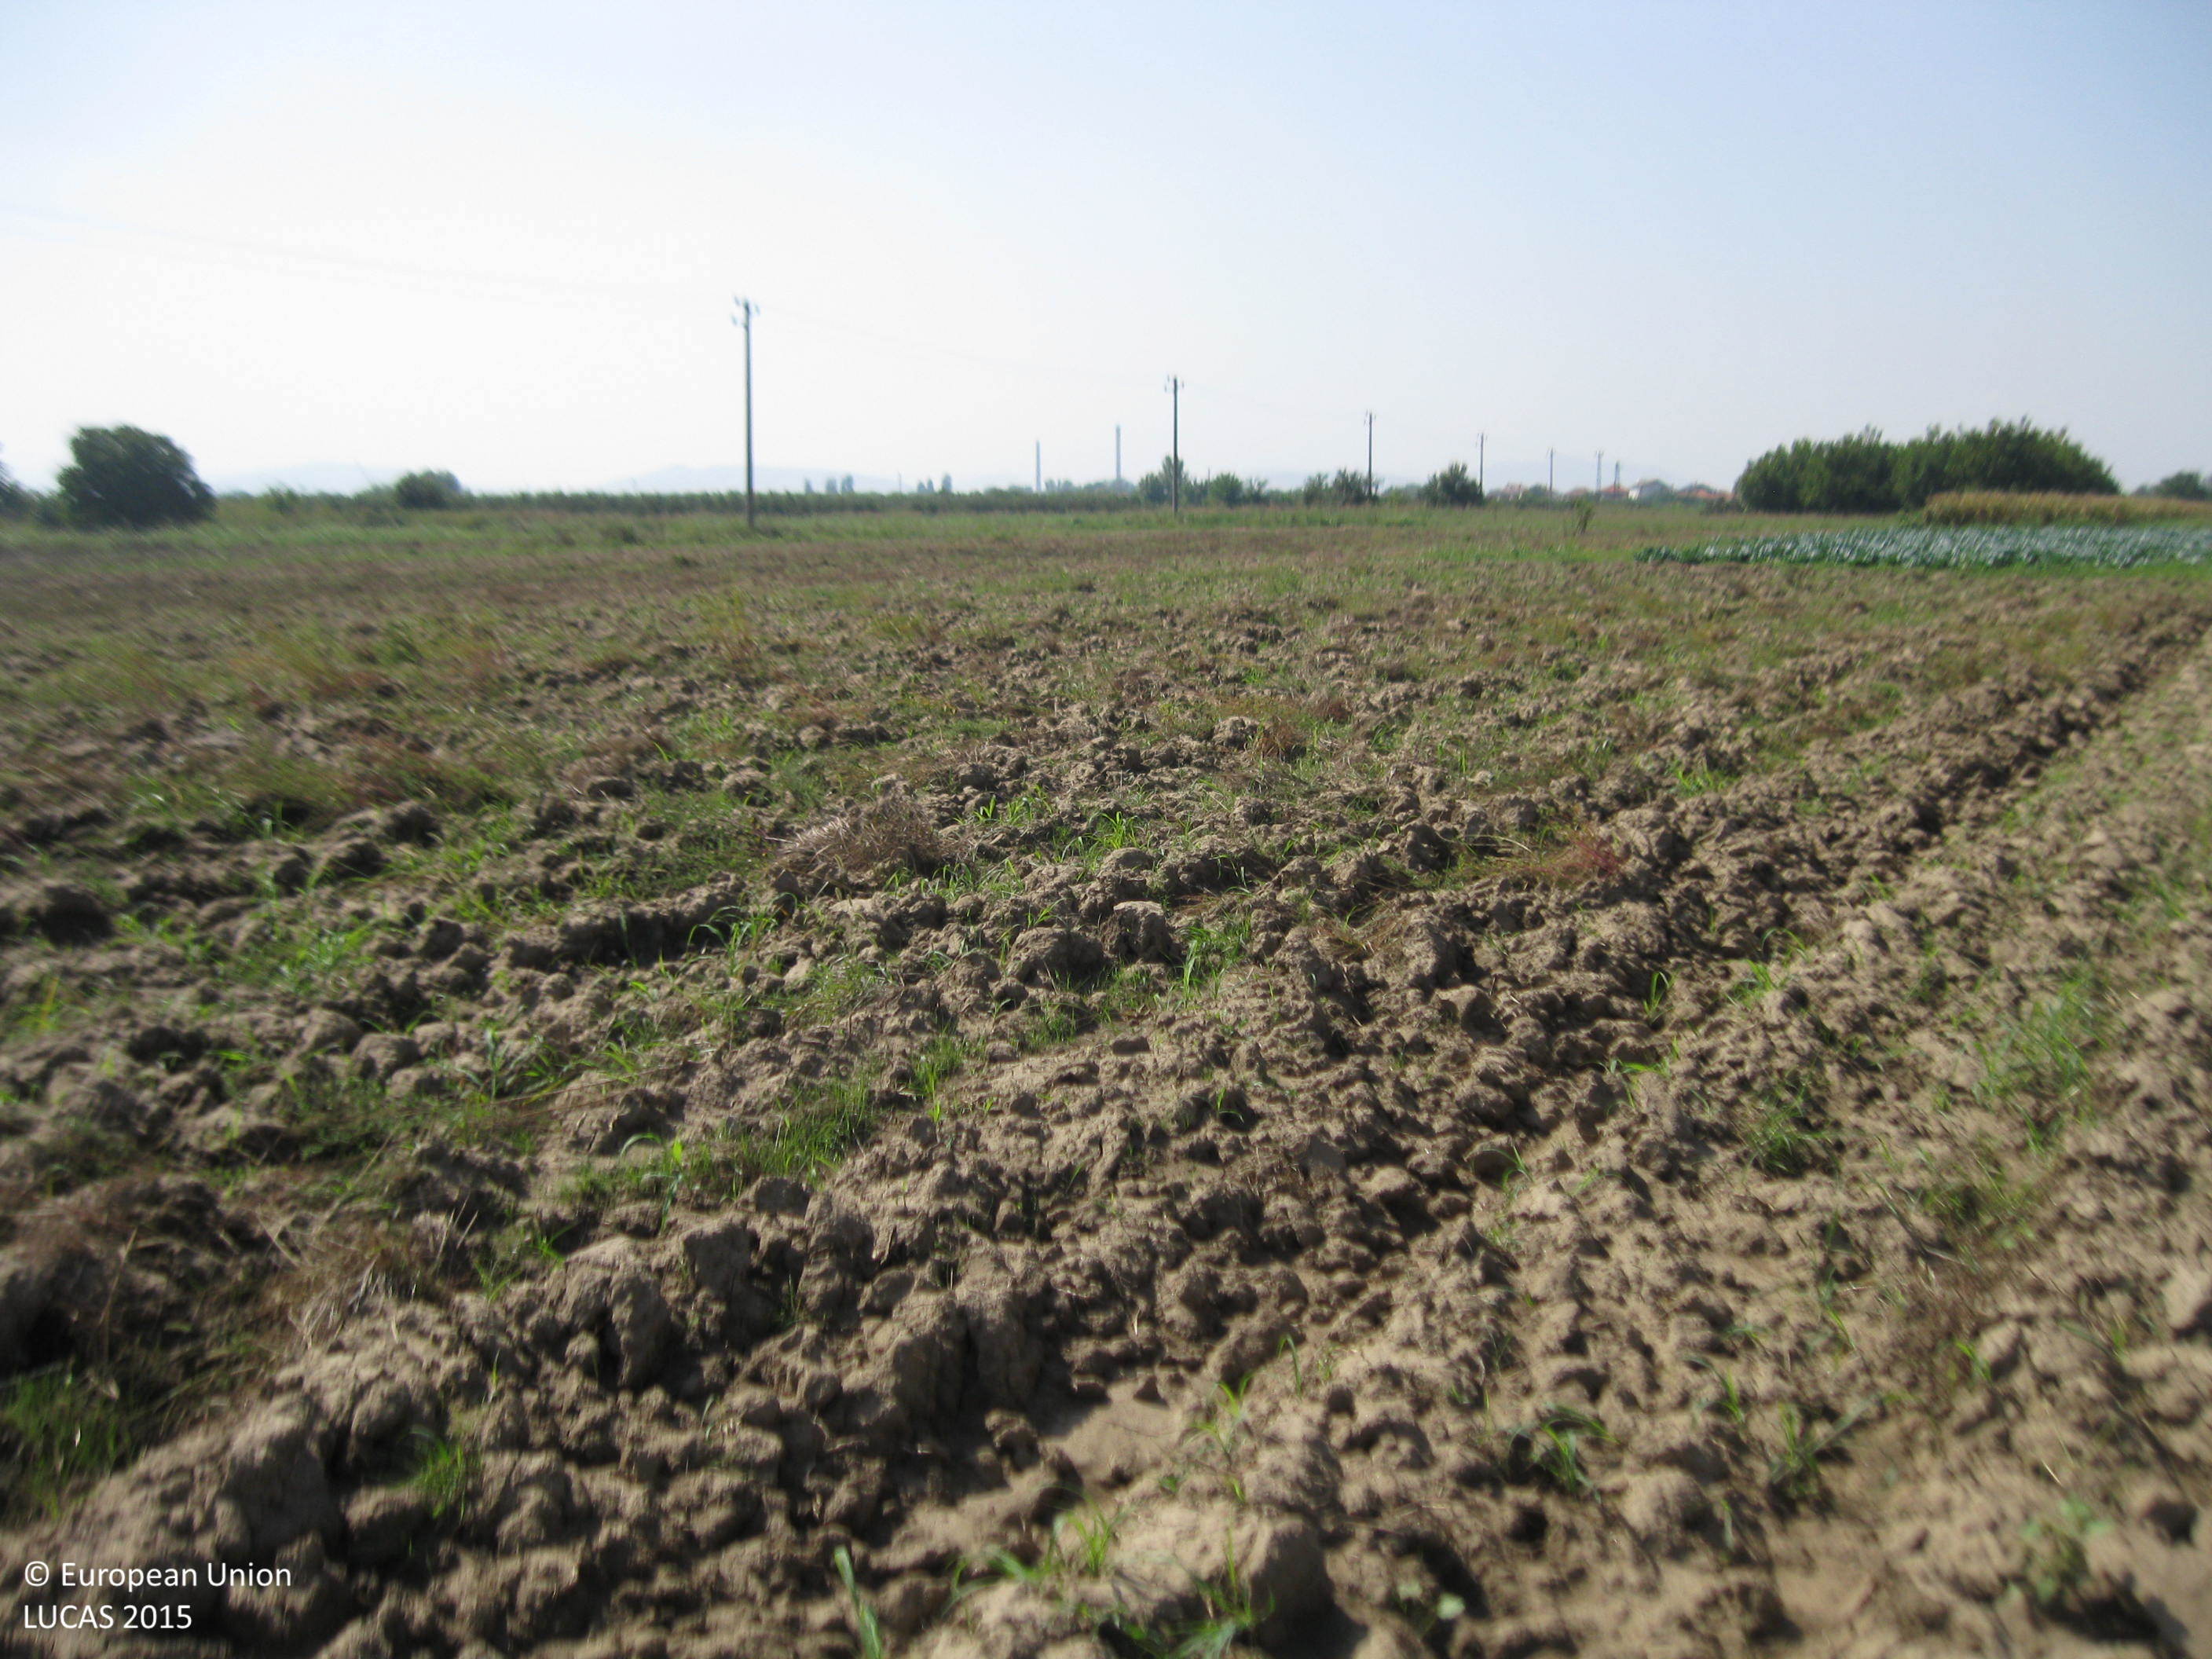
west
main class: Cropland
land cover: Common wheat
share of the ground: < 10 %
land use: Agriculture (excluding fallow land and kitchen gardens)
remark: Harvested field
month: September
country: BG
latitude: 42.1457
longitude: 24.5565
